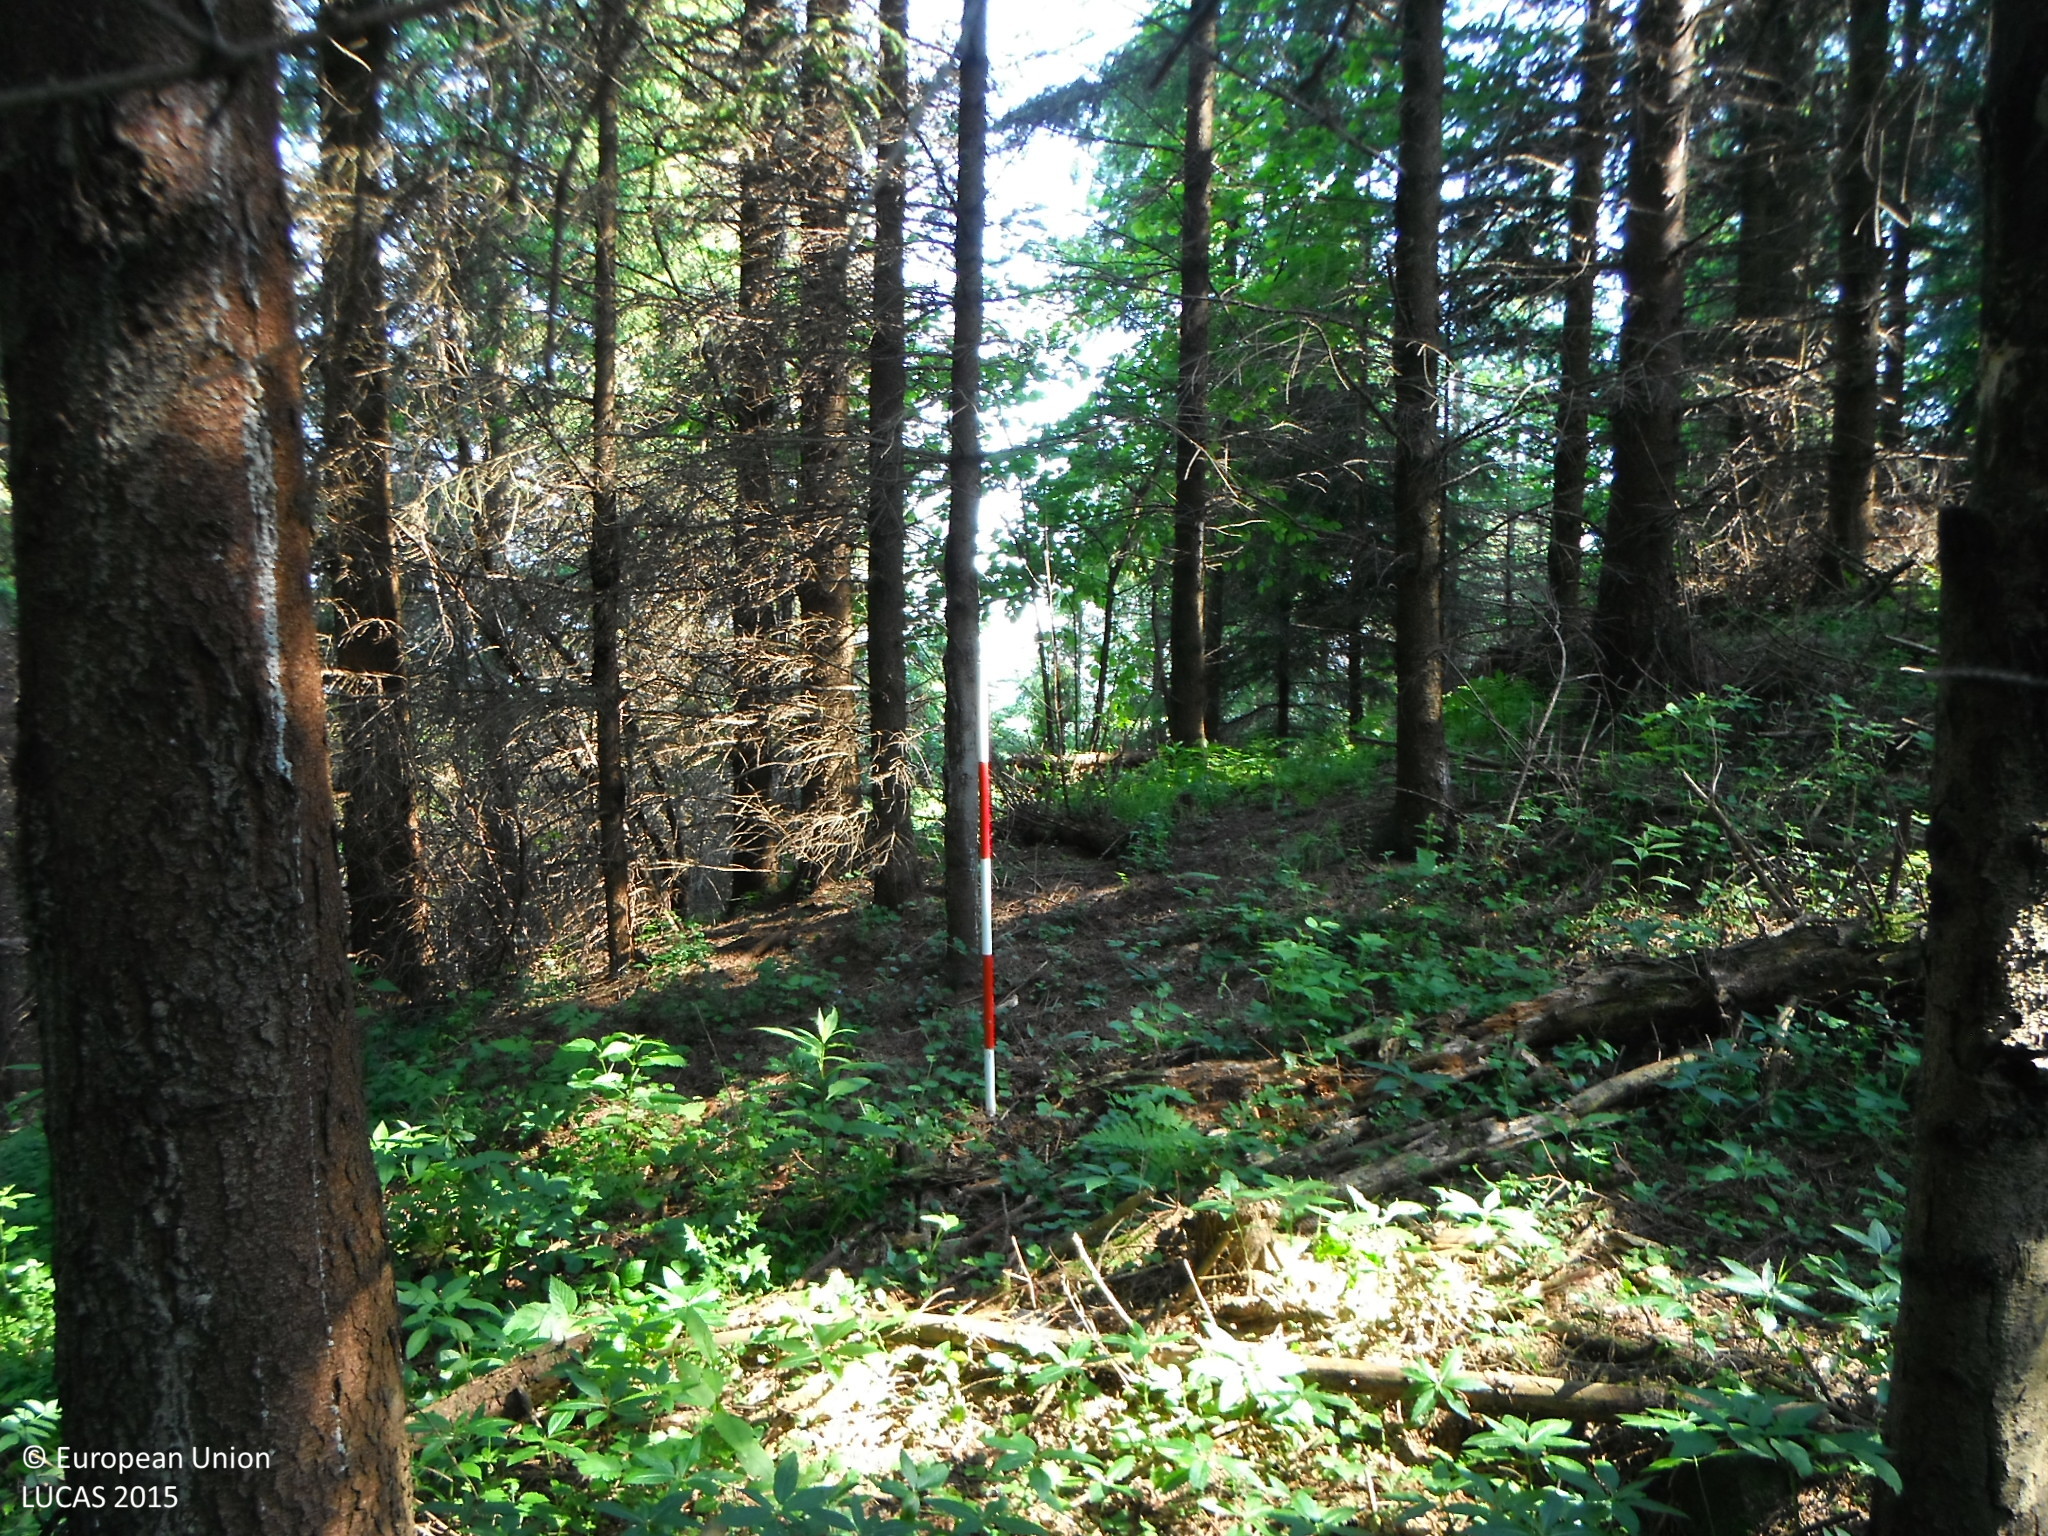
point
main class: Woodland
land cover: Spruce dominated coniferous woodland
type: alpine coniferous forest
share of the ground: > 75 %
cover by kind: coniferous forest trees 100 %
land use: Forestry
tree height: > 5 m
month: June
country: SK
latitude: 49.2551
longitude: 20.7701
